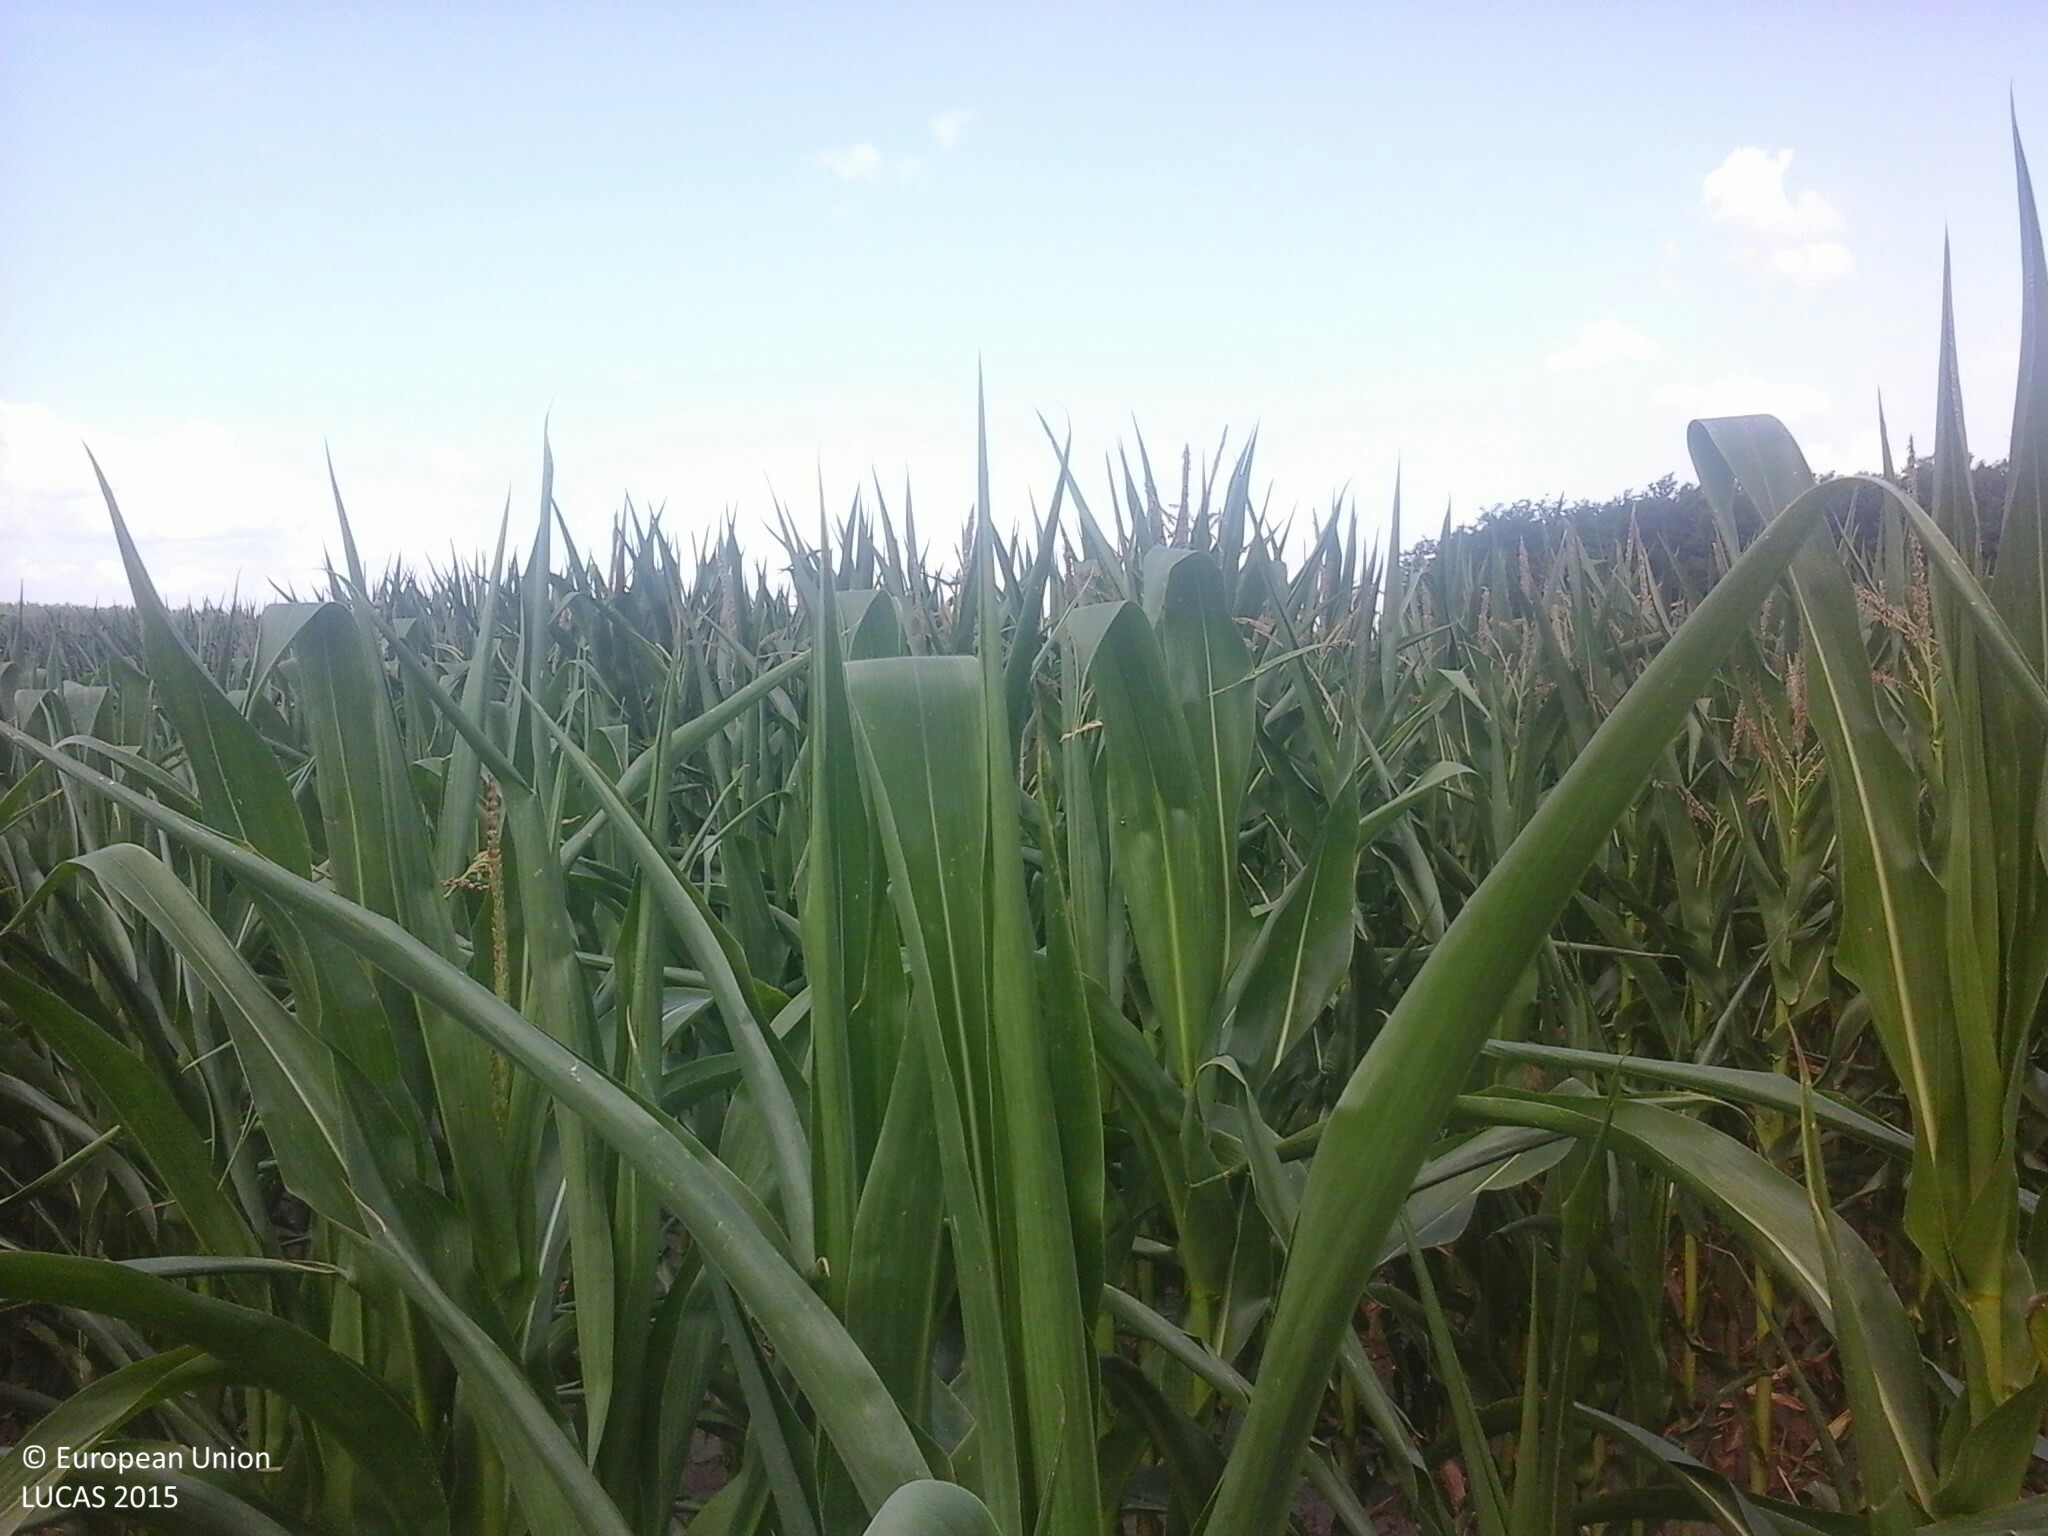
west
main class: Cropland
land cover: Maize
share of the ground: 50 - 75 %
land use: Agriculture (excluding fallow land and kitchen gardens)
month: July
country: HU
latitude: 47.8461
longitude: 22.2555
